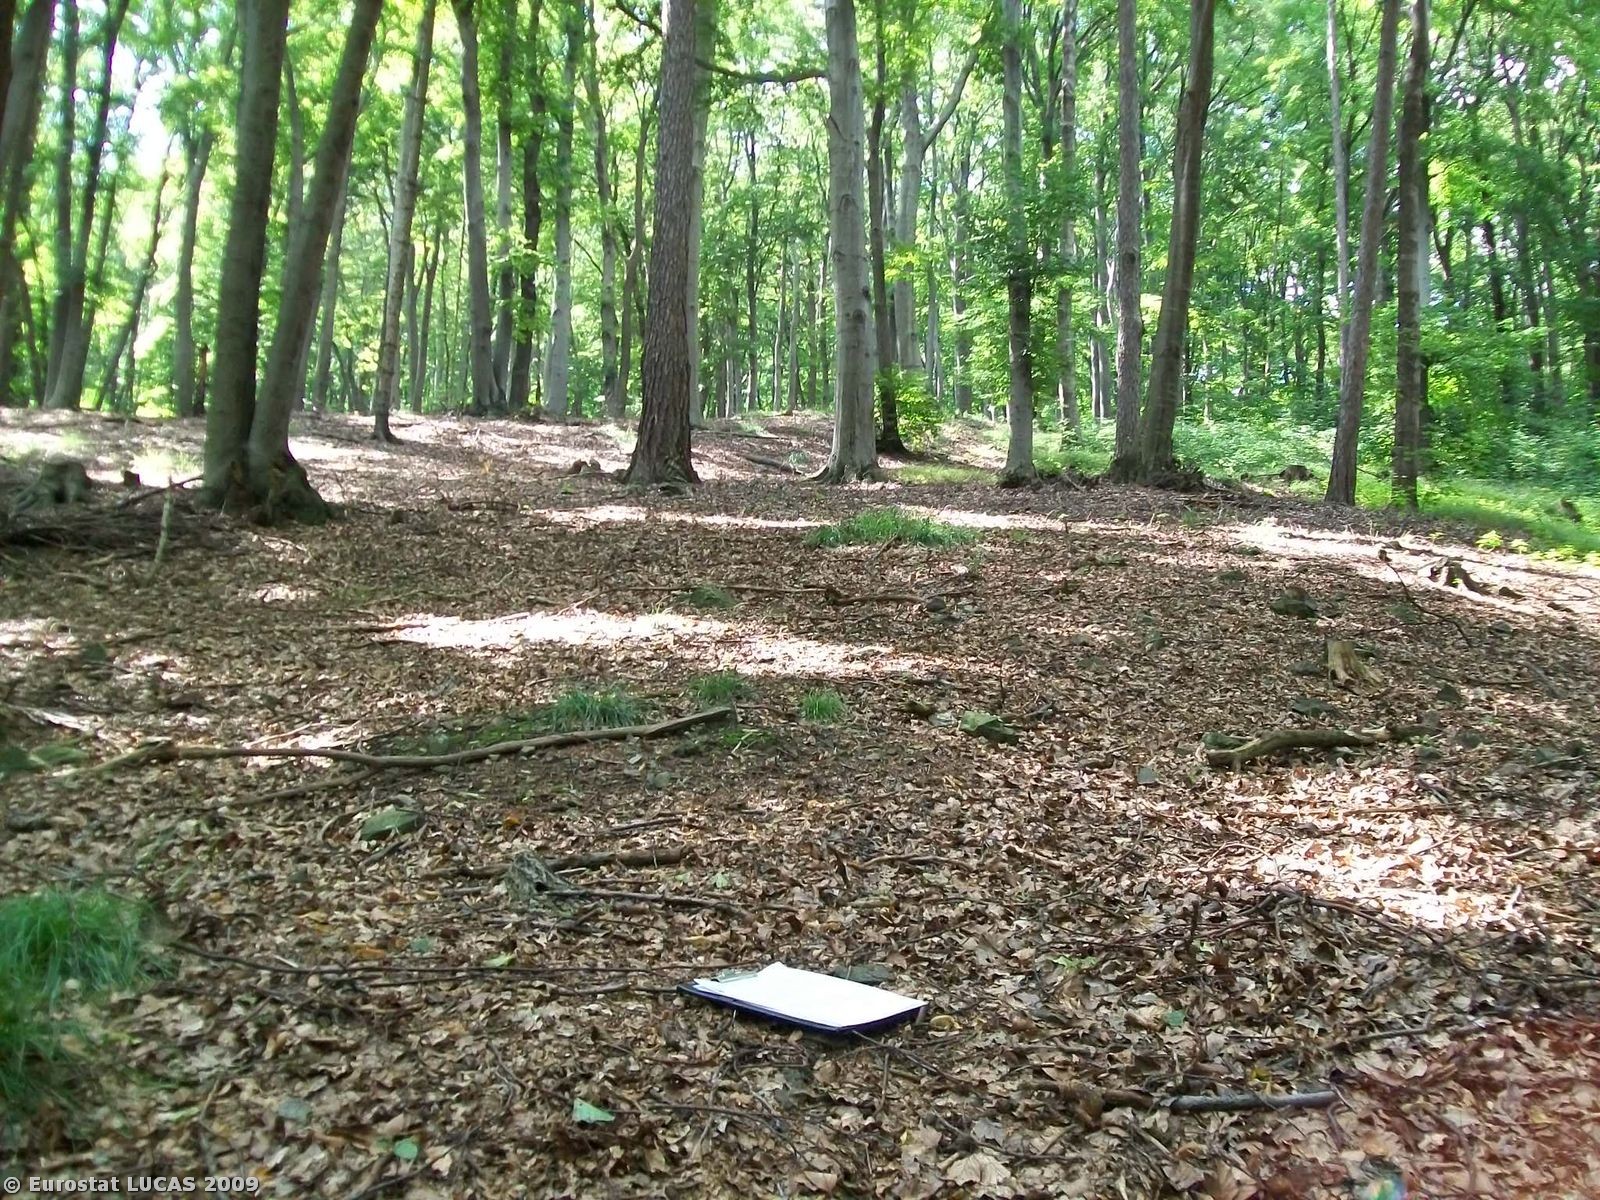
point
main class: Woodland
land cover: Broadleaved woodland
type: beech forest
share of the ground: > 75 %
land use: Amenities, museums, leisure
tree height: > 5 m
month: August
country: PL
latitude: 50.8874
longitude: 16.7326
